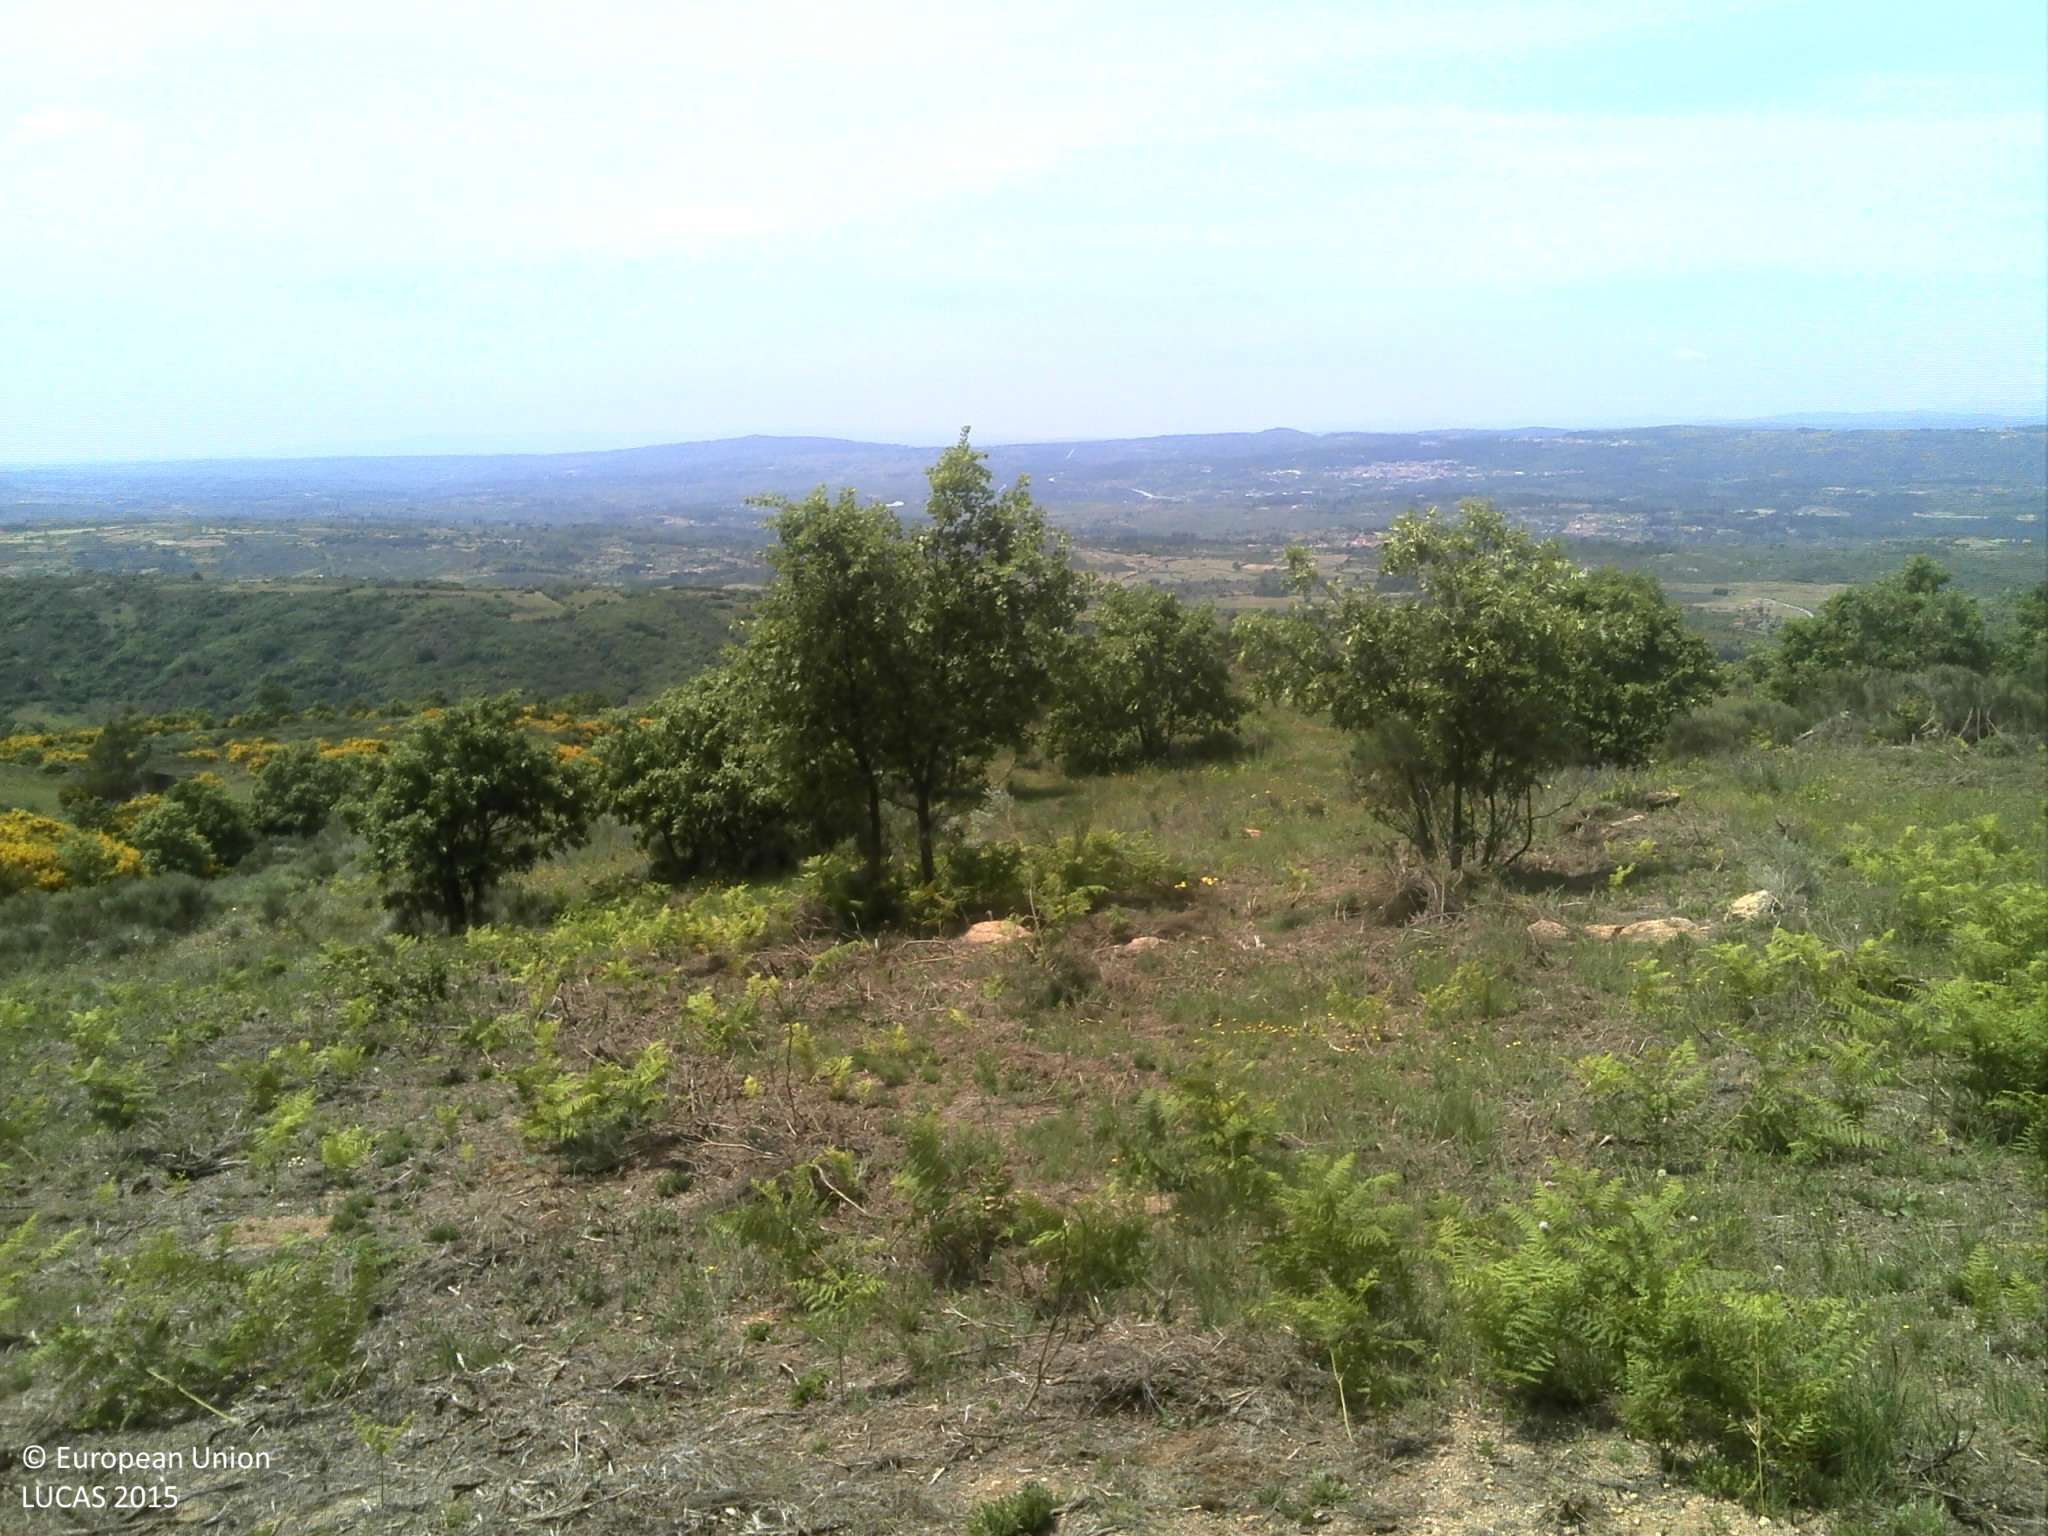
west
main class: Shrubland
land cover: Shrubland without tree cover
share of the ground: 50 - 75 %
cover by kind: shrubs 50 %, unconsolidated bare surface 40 %, herbaceous plants 10 %
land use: Abandoned areas
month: May
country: PT
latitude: 40.5780
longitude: -7.4169
